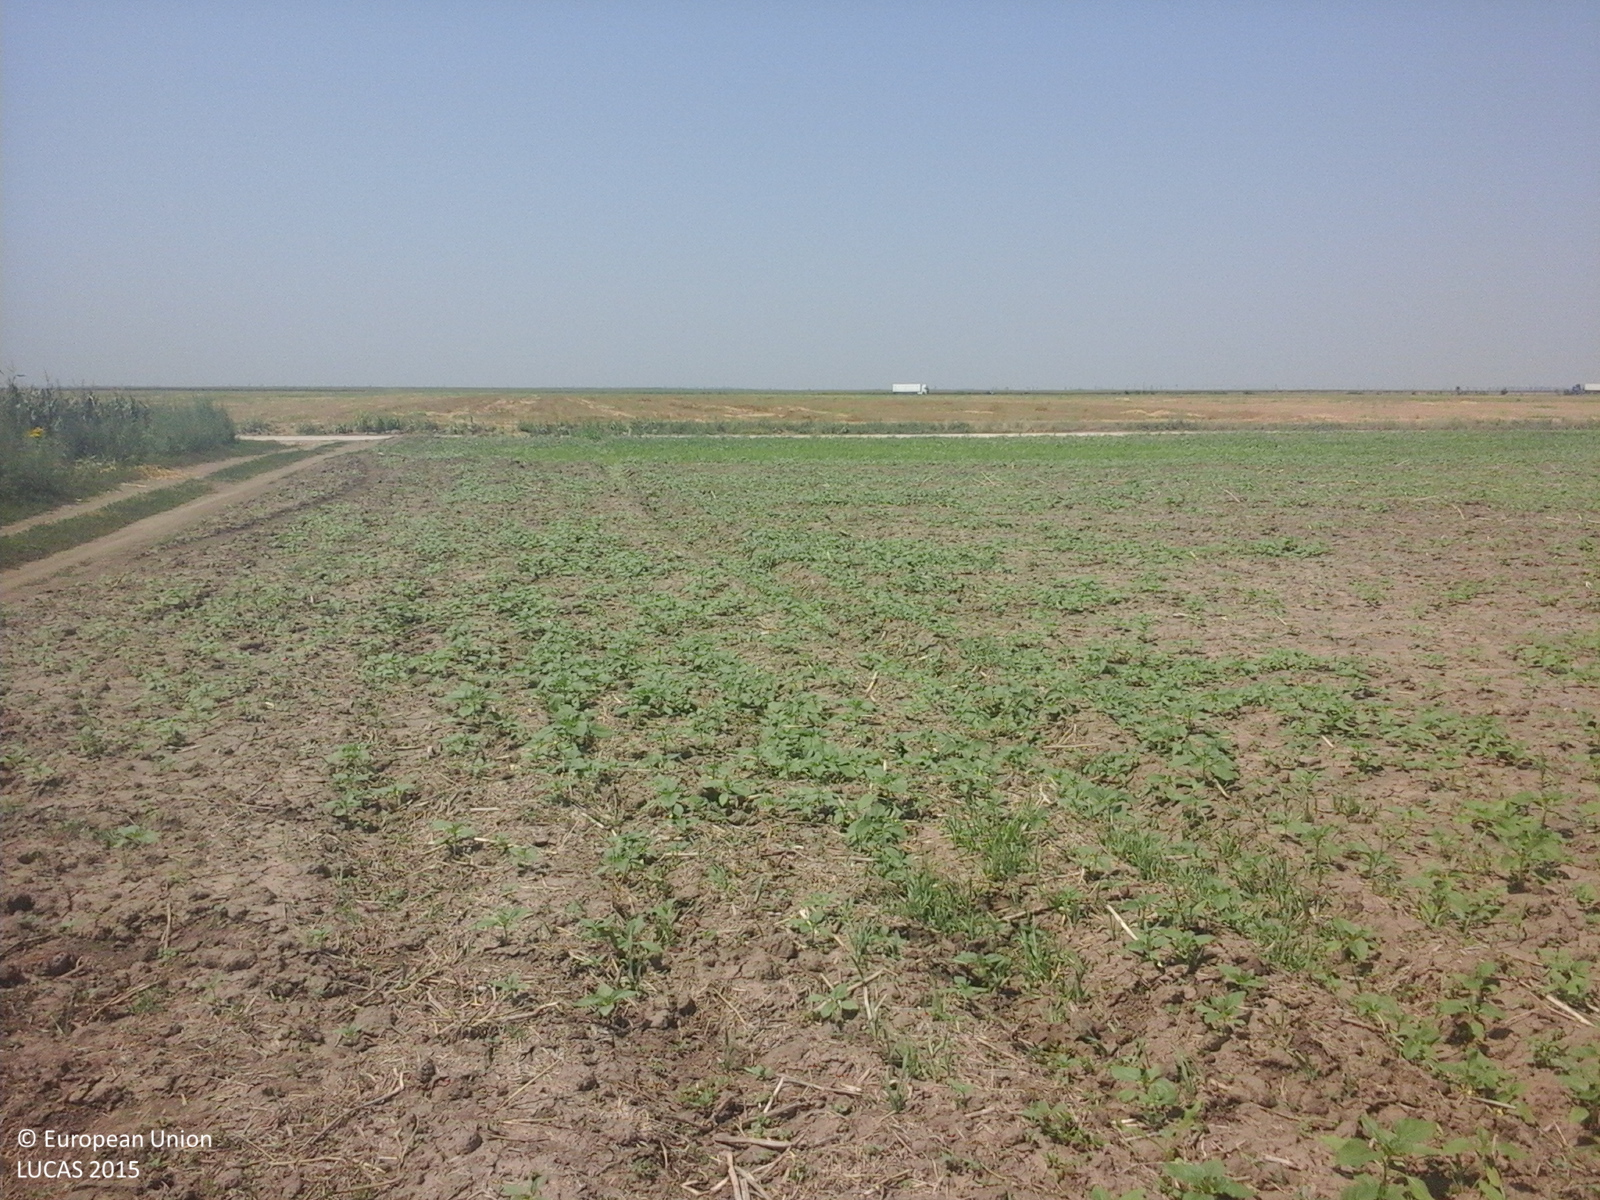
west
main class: Grassland
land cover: Spontaneously vegetated surfaces
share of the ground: > 75 %
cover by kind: herbaceous plants 100 %
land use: Fallow land
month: July
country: RO
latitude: 44.7529
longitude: 27.4627
